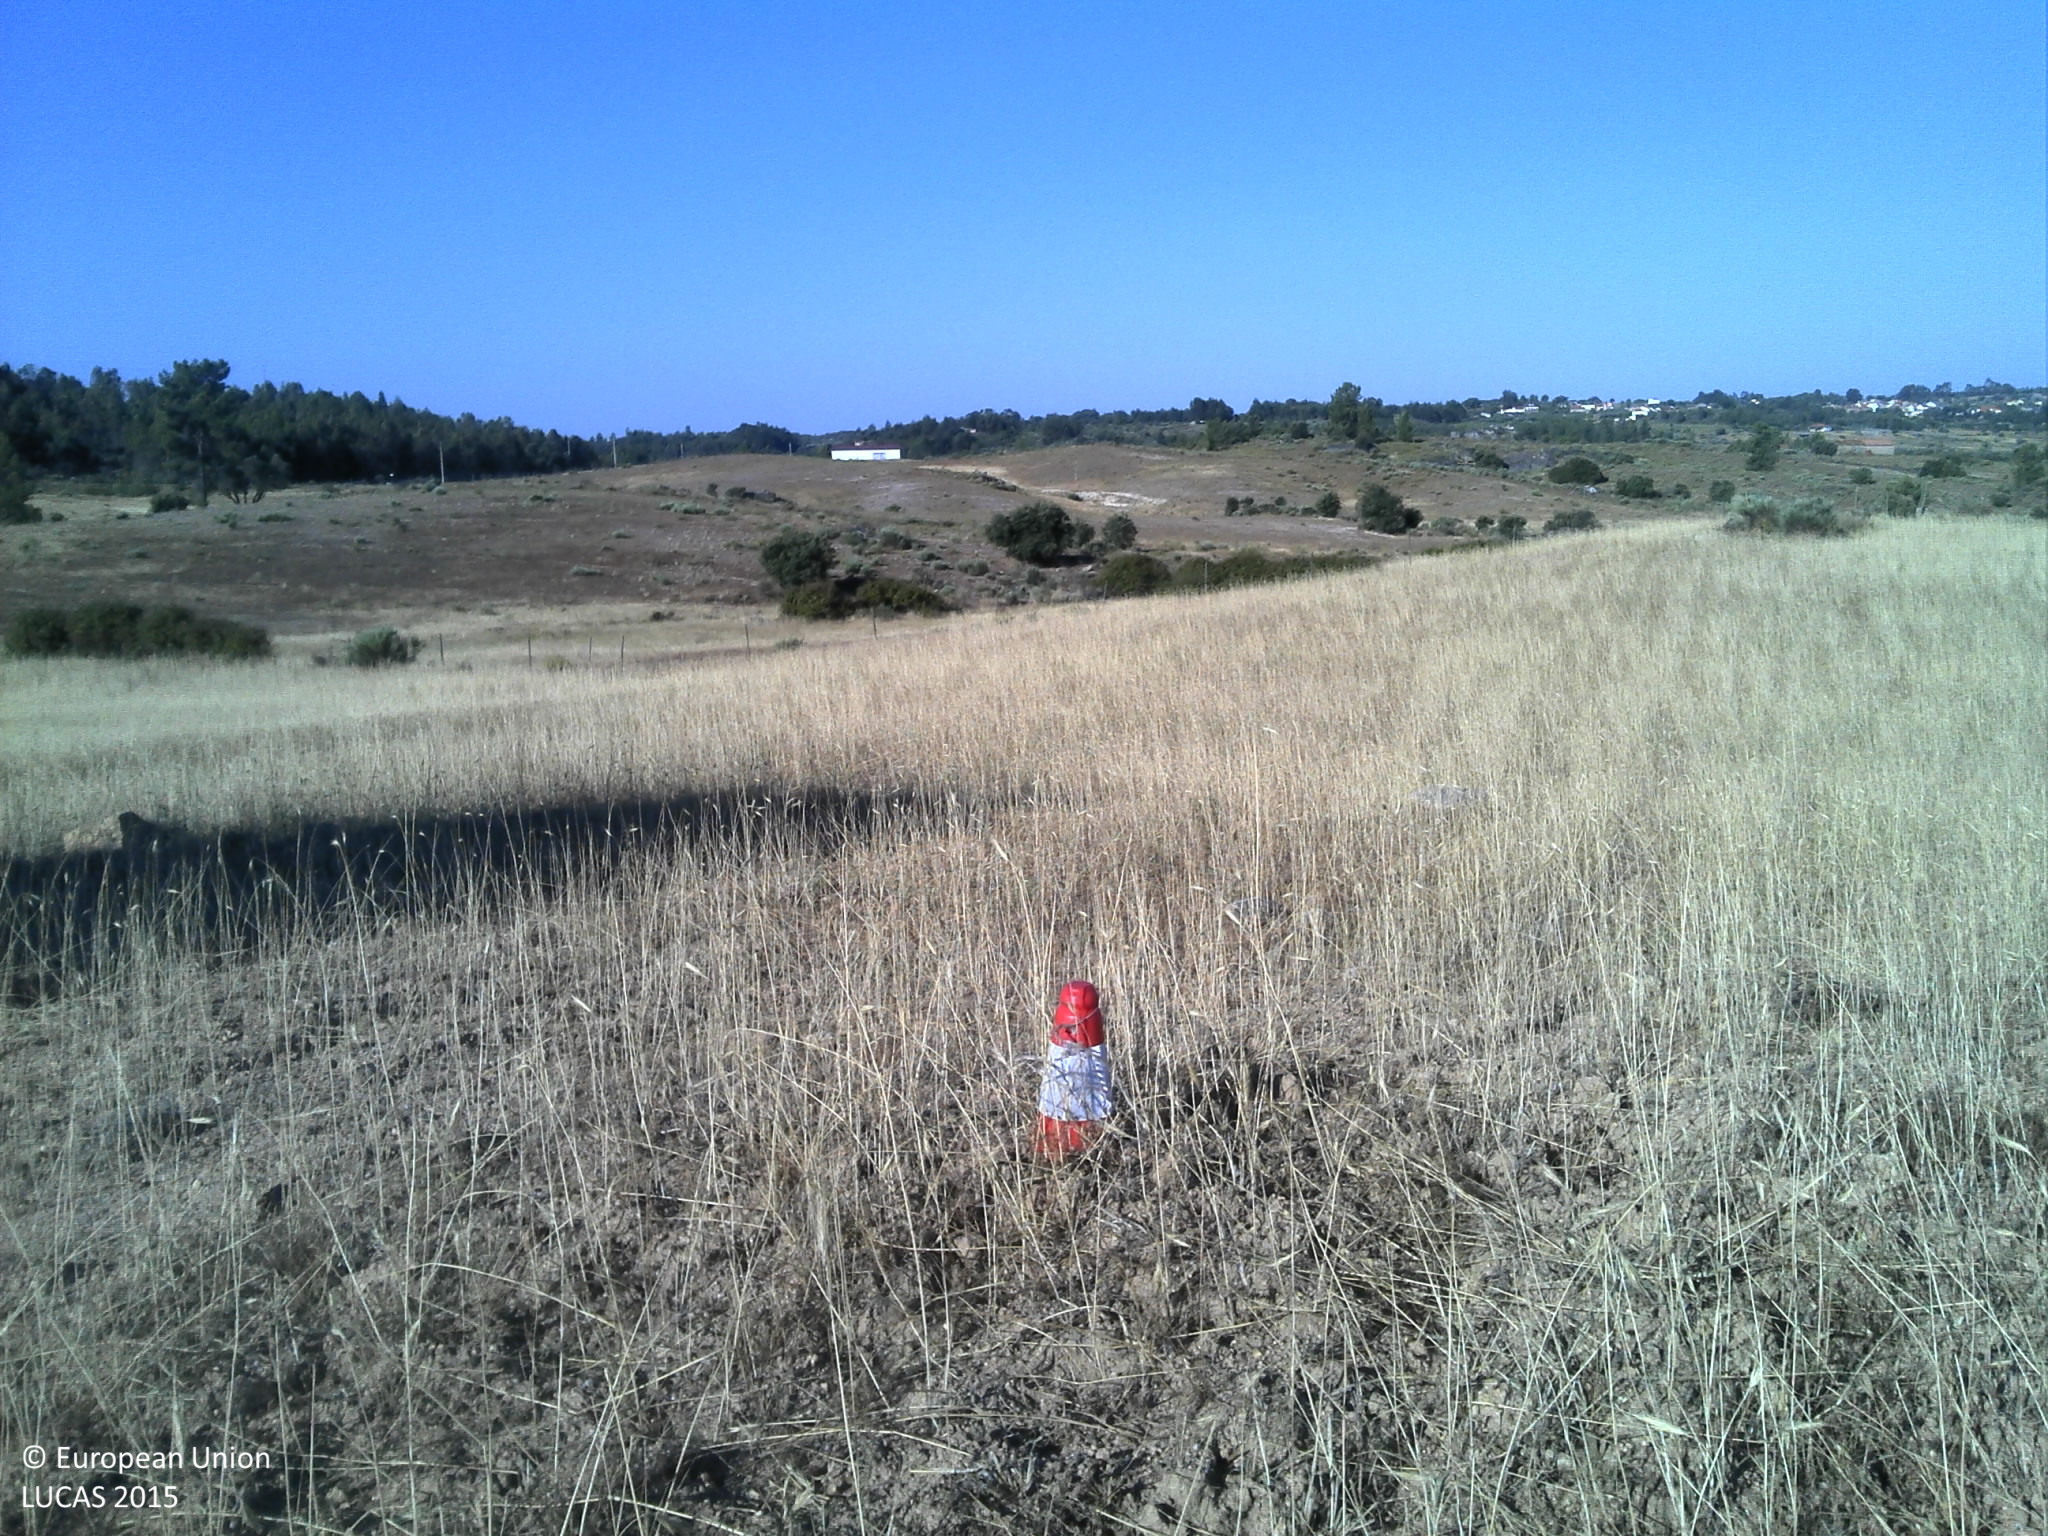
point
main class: Grassland
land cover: Grassland with sparse tree/shrub cover
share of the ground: 25 - 50 %
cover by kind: herbaceous plants 45 %, unconsolidated bare surface 40 %, shrubs 10 %, broadleaved forest trees 5 %
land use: Agriculture (excluding fallow land and kitchen gardens)
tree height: < 5 m
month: June
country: PT
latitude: 40.0821
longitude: -7.3030
